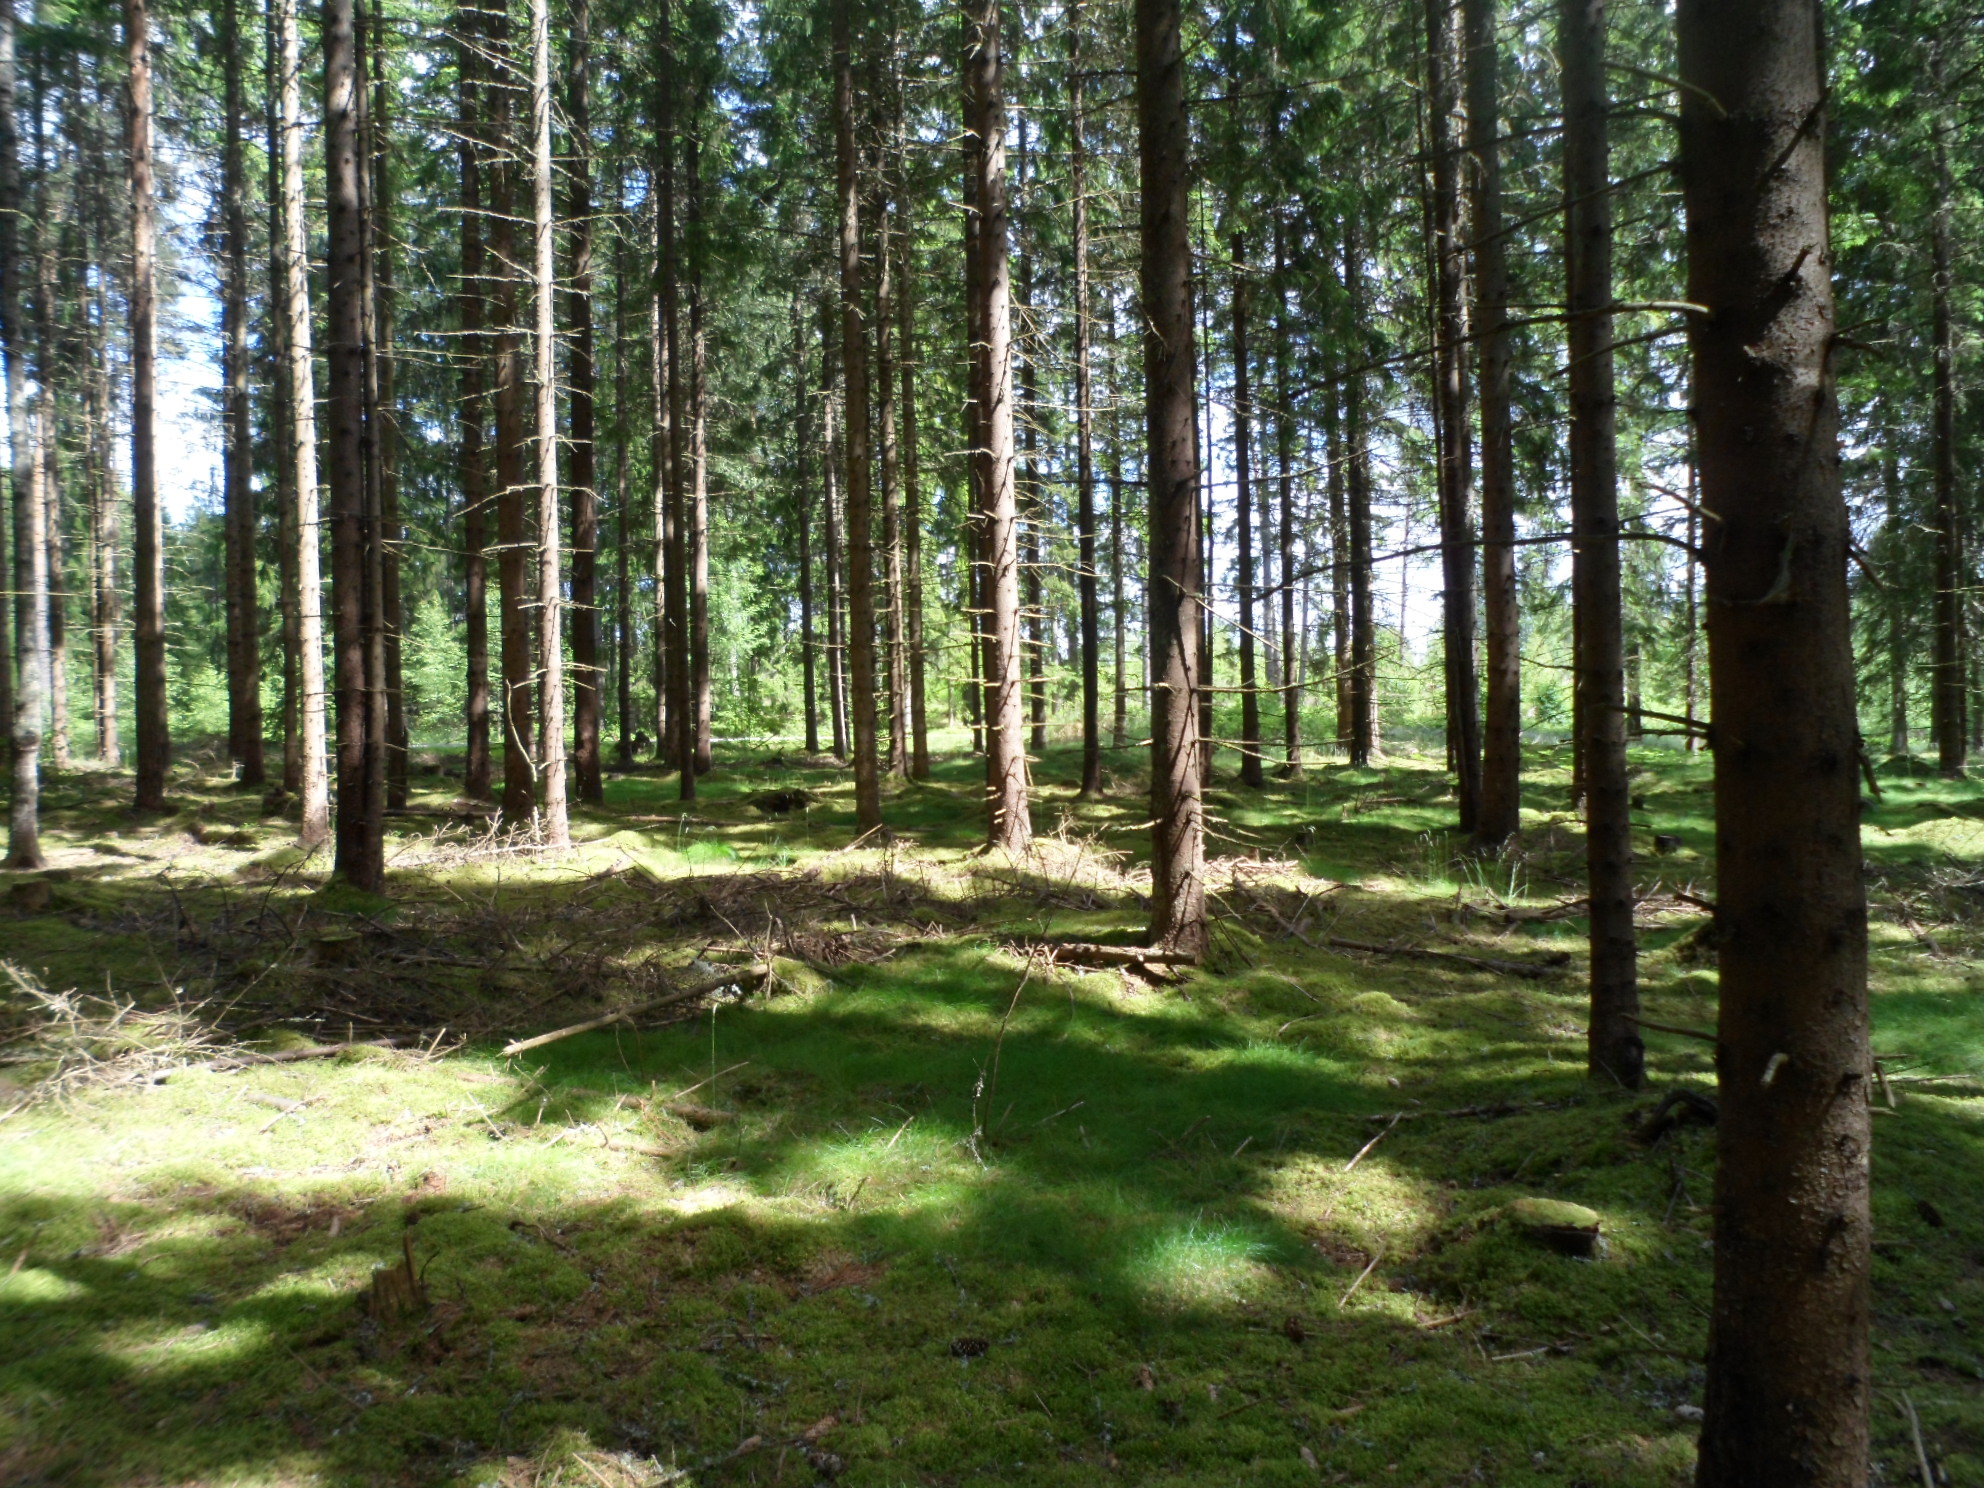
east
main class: Woodland
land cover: Spruce dominated coniferous woodland
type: boreal forest
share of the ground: 50 - 75 %
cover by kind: coniferous forest trees 65 %, lichens and mosses 20 %, shrubs 10 %, unconsolidated bare surface 5 %
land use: Forestry
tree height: > 5 m
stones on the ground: < 10 %
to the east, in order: Spruce dominated coniferous woodland; Tracks; Spruce dominated mixed woodland; Broadleaved woodland; Grass margins; Paved roads, cycling and walking lanes; Shrubland with sparse tree cover; Spruce dominated coniferous woodland; Tracks; Spruce dominated mixed woodland; Paved roads, cycling and walking lanes; Spruce dominated mixed woodland; Artificial constructions in urban areas
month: June
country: SE
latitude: 57.1080
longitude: 14.7682
